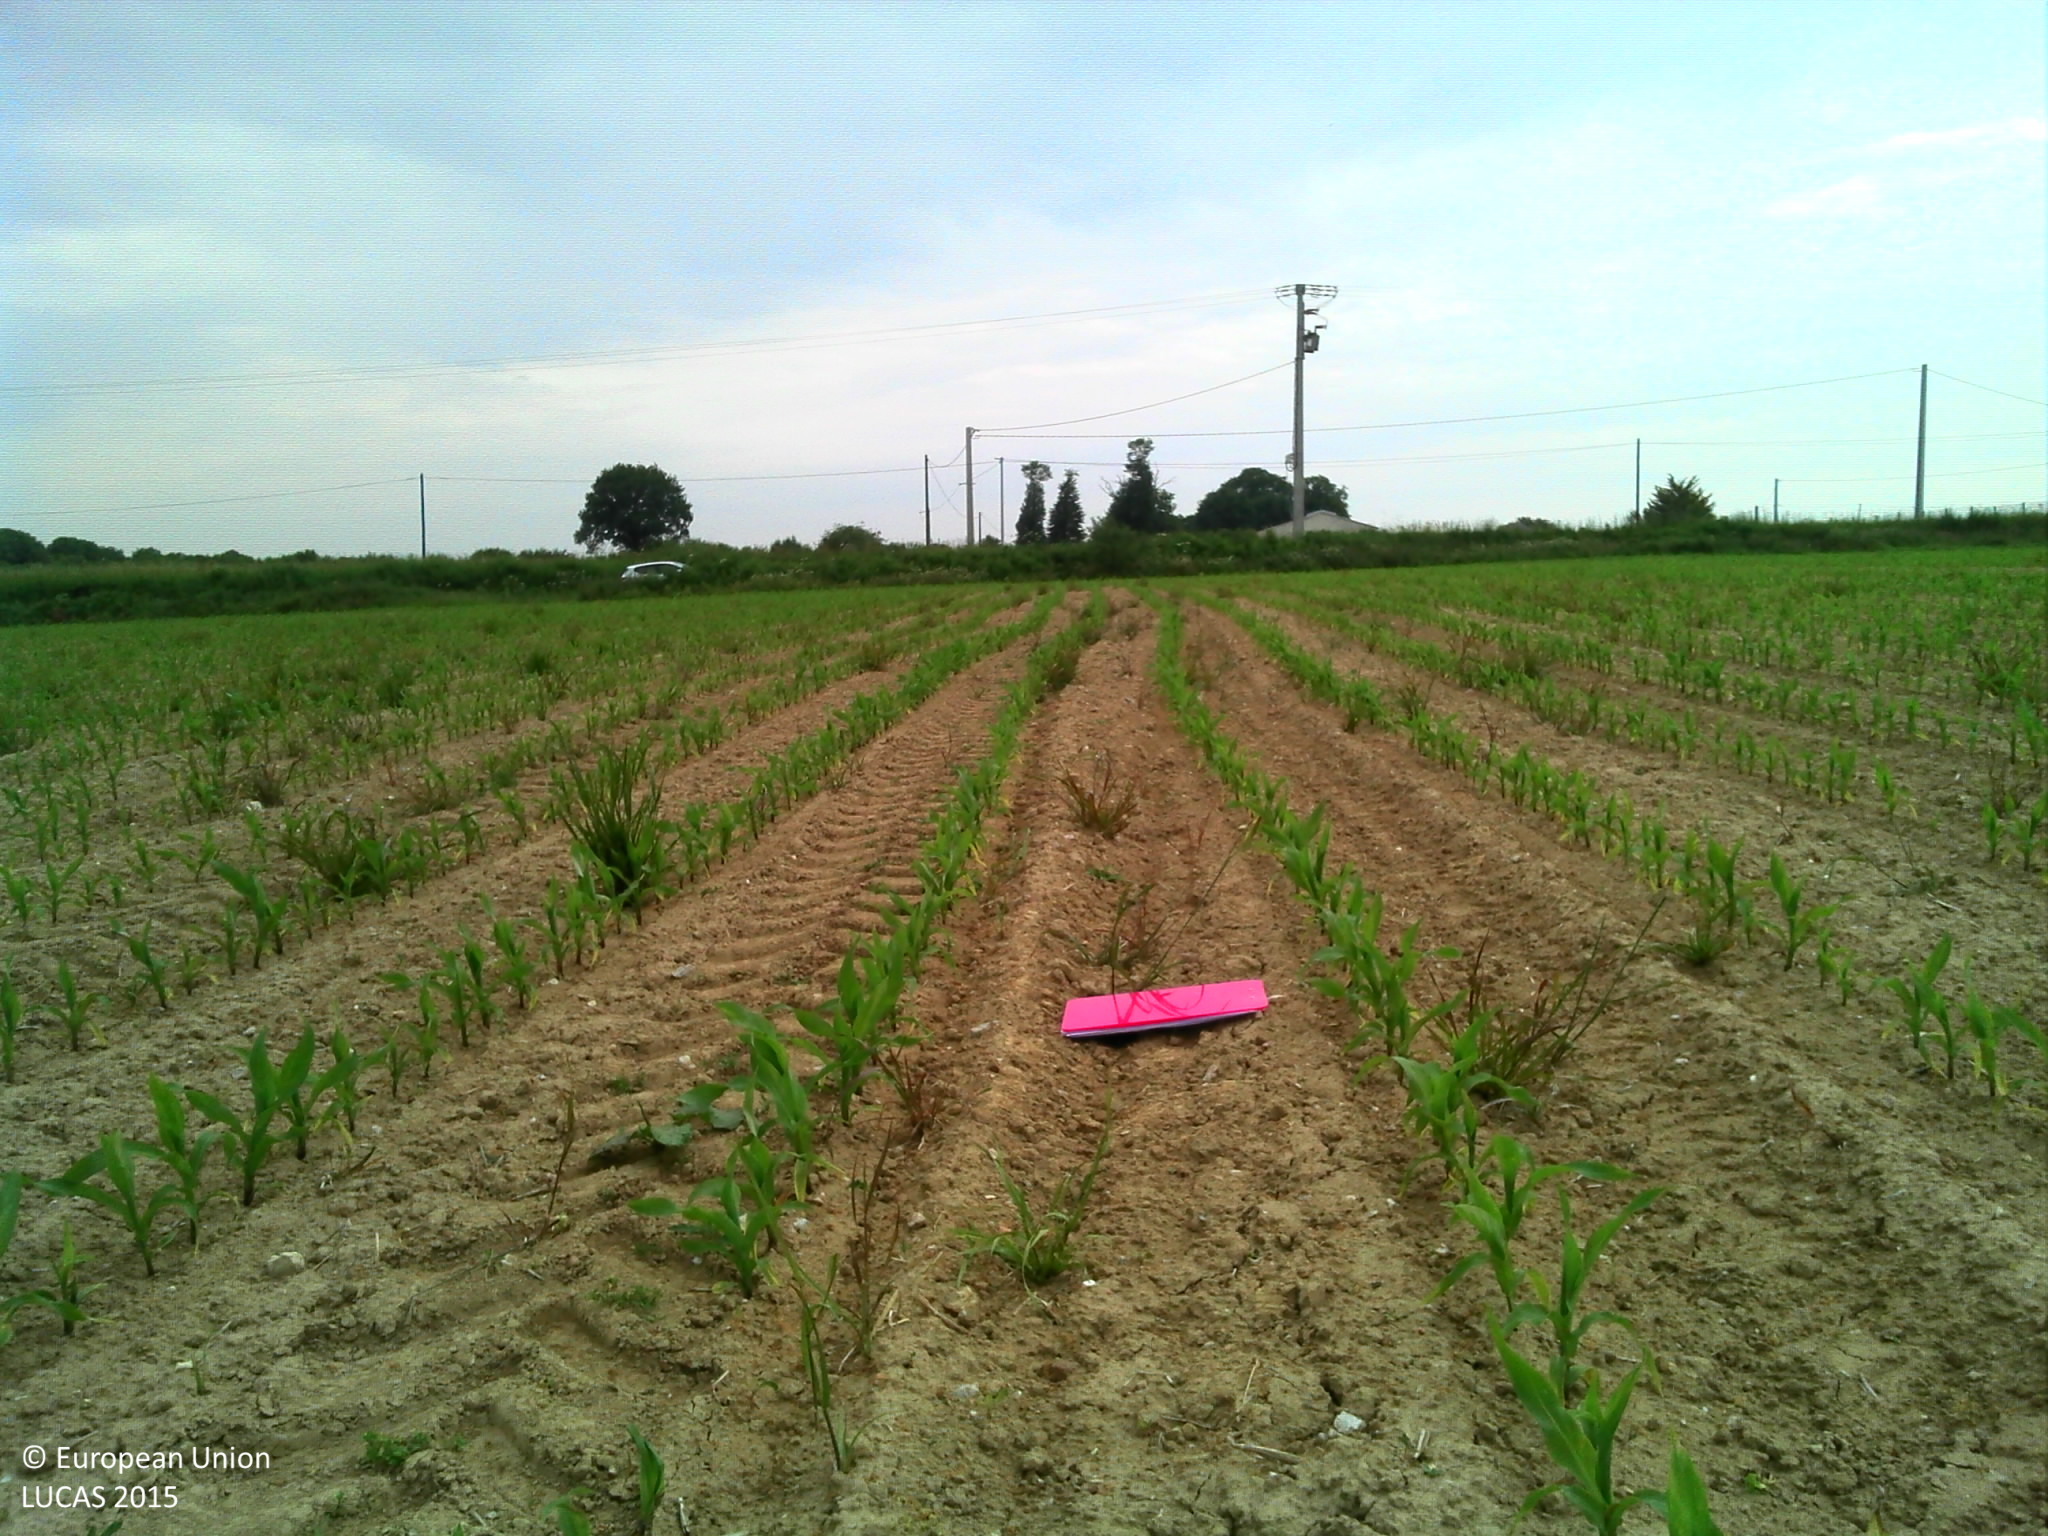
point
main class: Cropland
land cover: Maize
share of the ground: 10 - 25 %
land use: Agriculture (excluding fallow land and kitchen gardens)
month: June
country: FR
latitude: 48.1709
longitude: -2.1164
